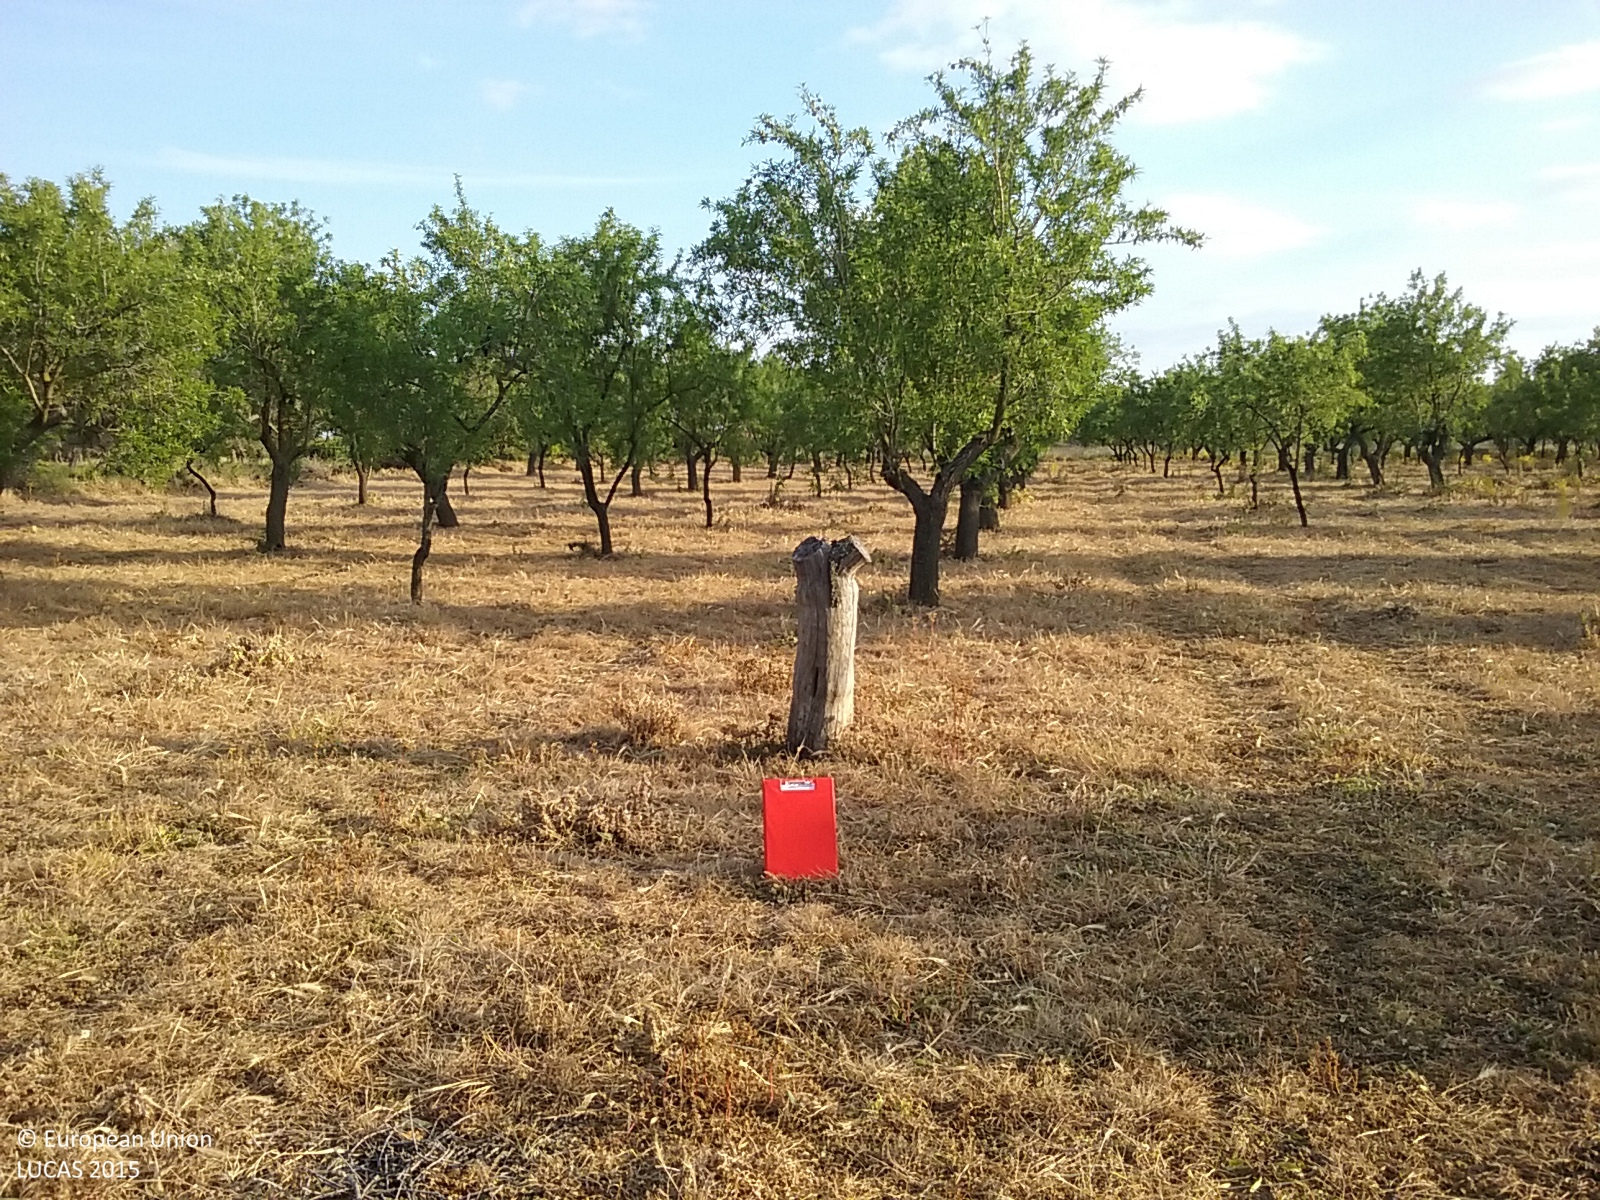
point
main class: Cropland
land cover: Nuts trees
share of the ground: 25 - 50 %
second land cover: Grassland without tree/shrub cover
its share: > 75 %
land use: Agriculture (excluding fallow land and kitchen gardens)
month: April
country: ES
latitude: 40.6313
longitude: 0.3829
